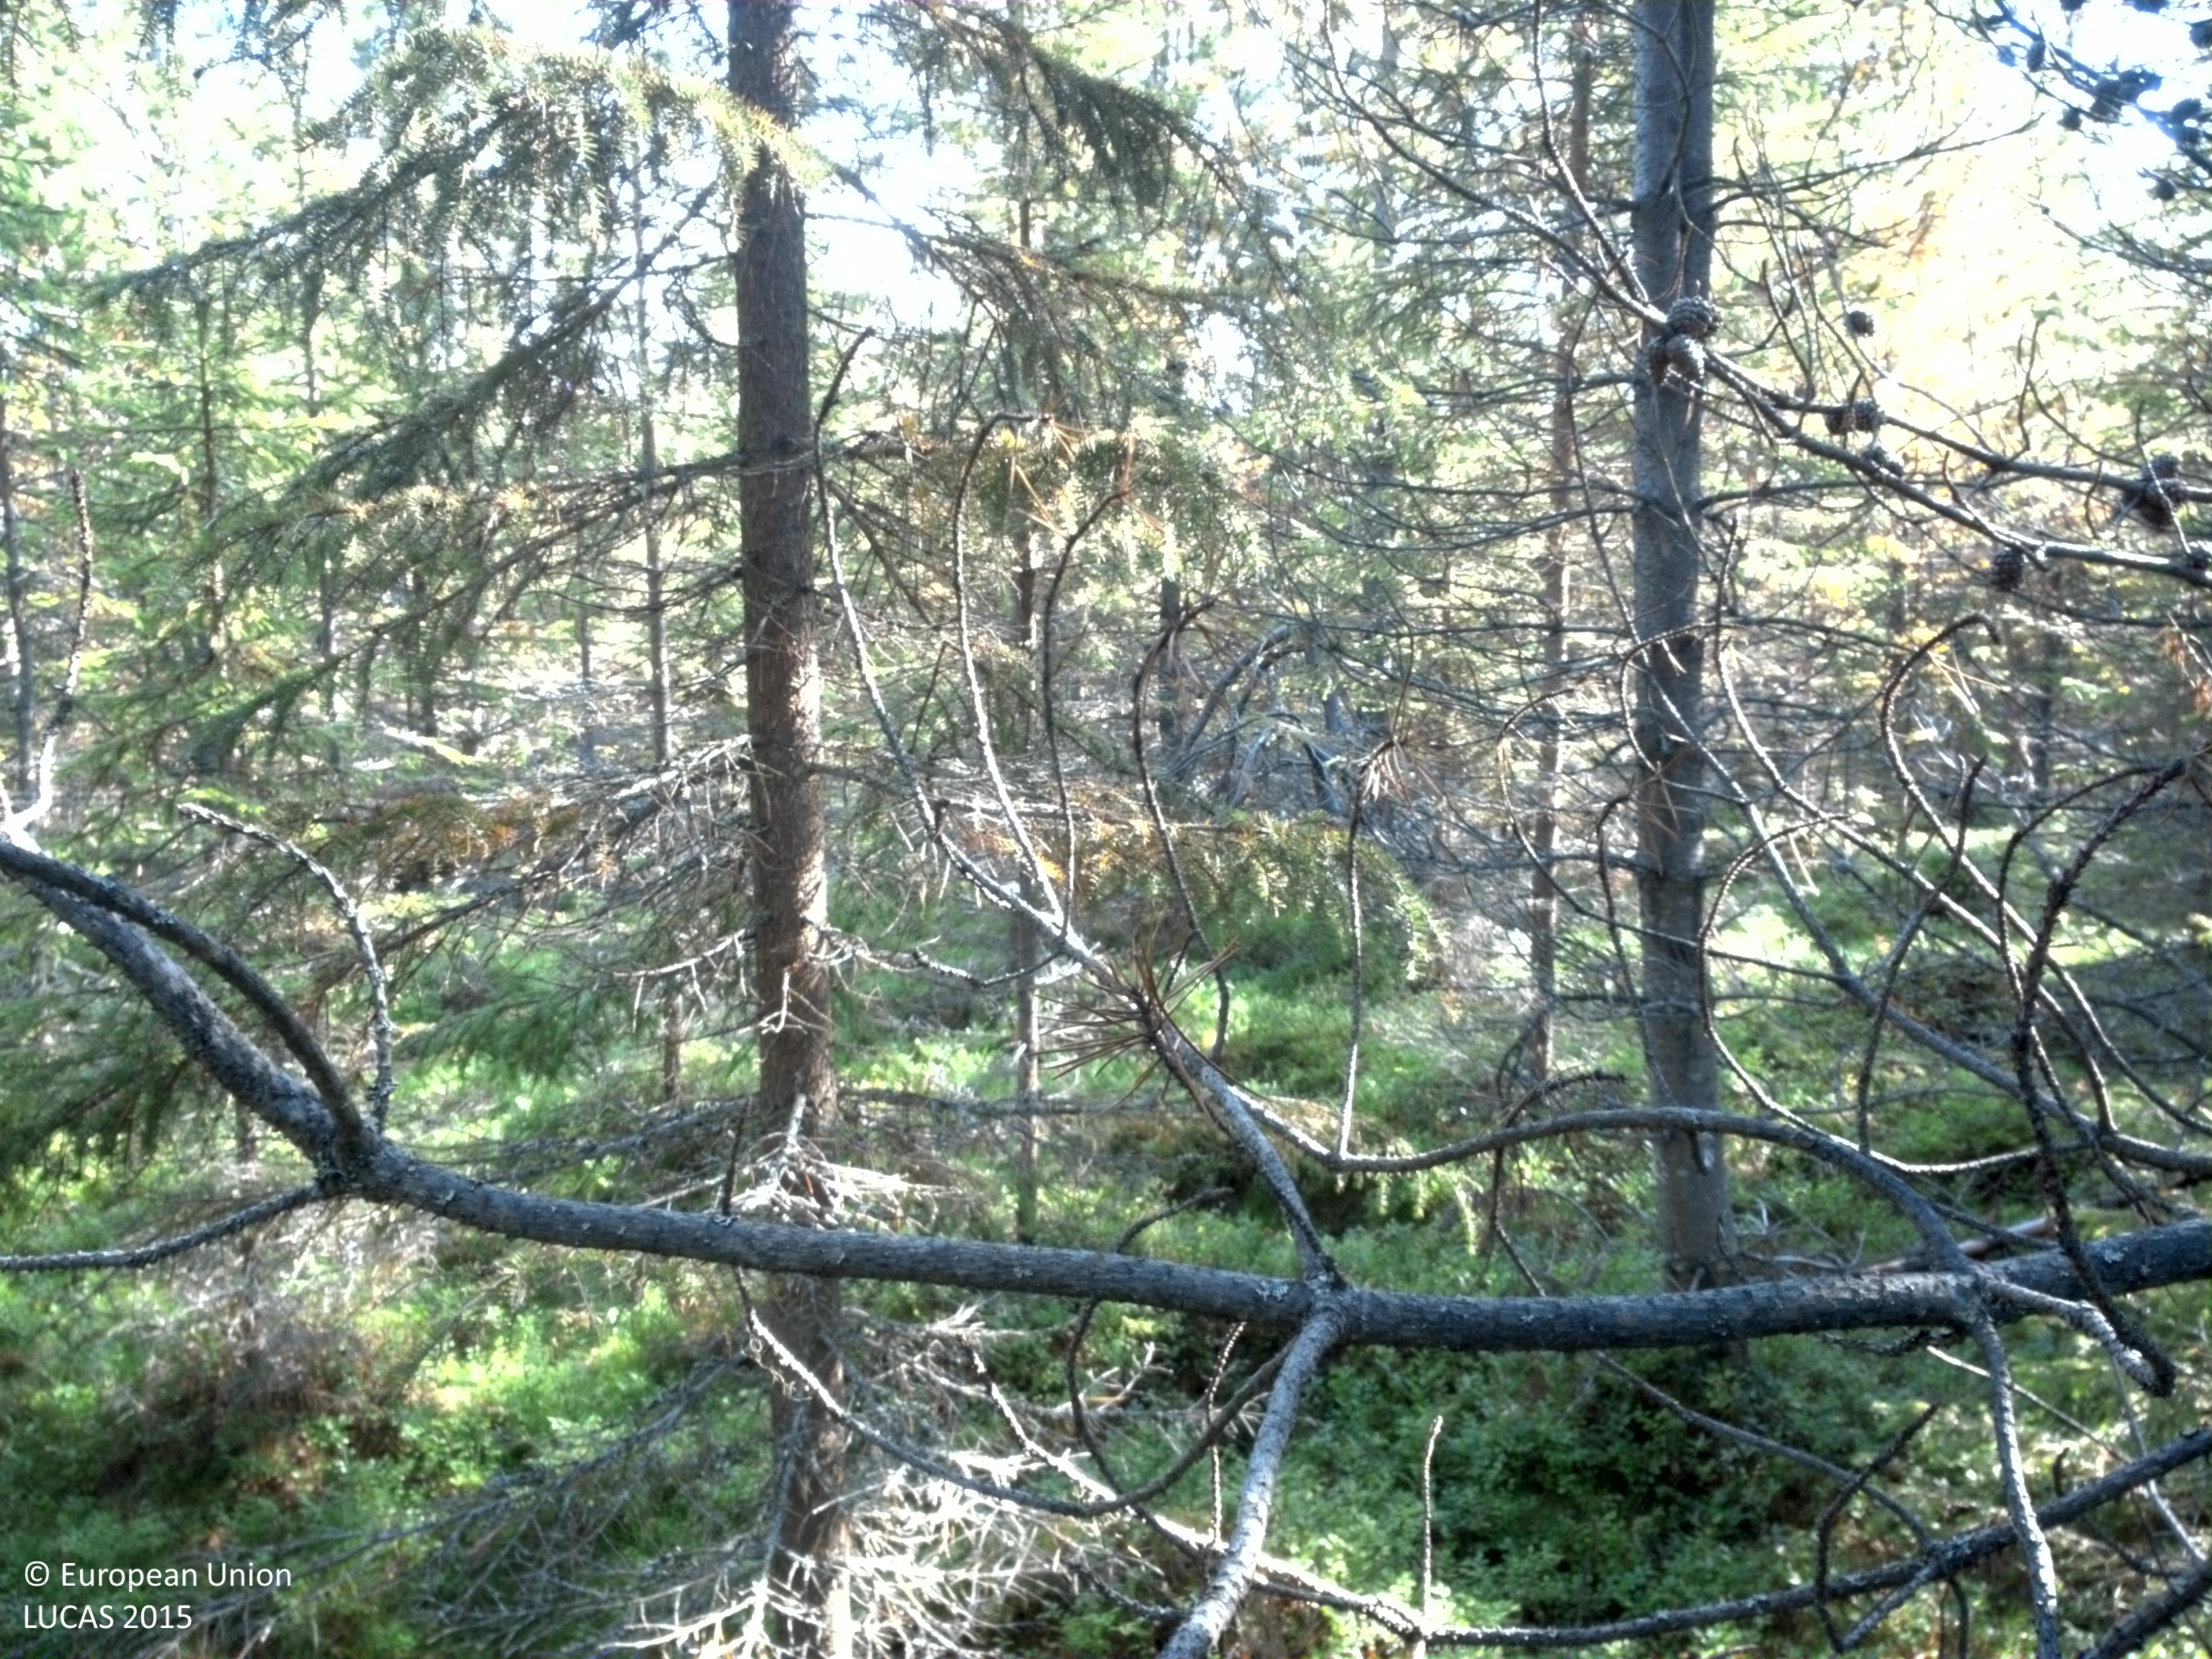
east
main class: Woodland
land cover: Pine dominated coniferous woodland
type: exotic forest
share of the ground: 50 - 75 %
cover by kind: coniferous forest trees 55 %, shrubs 30 %, broadleaved forest trees 5 %, herbaceous plants 5 %, lichens and mosses 5 %
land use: Forestry
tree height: > 5 m
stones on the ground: < 10 %
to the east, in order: Pine dominated coniferous woodland; Other mixed woodland; Pine dominated mixed woodland
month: September
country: SE
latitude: 65.1212
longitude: 16.8442
